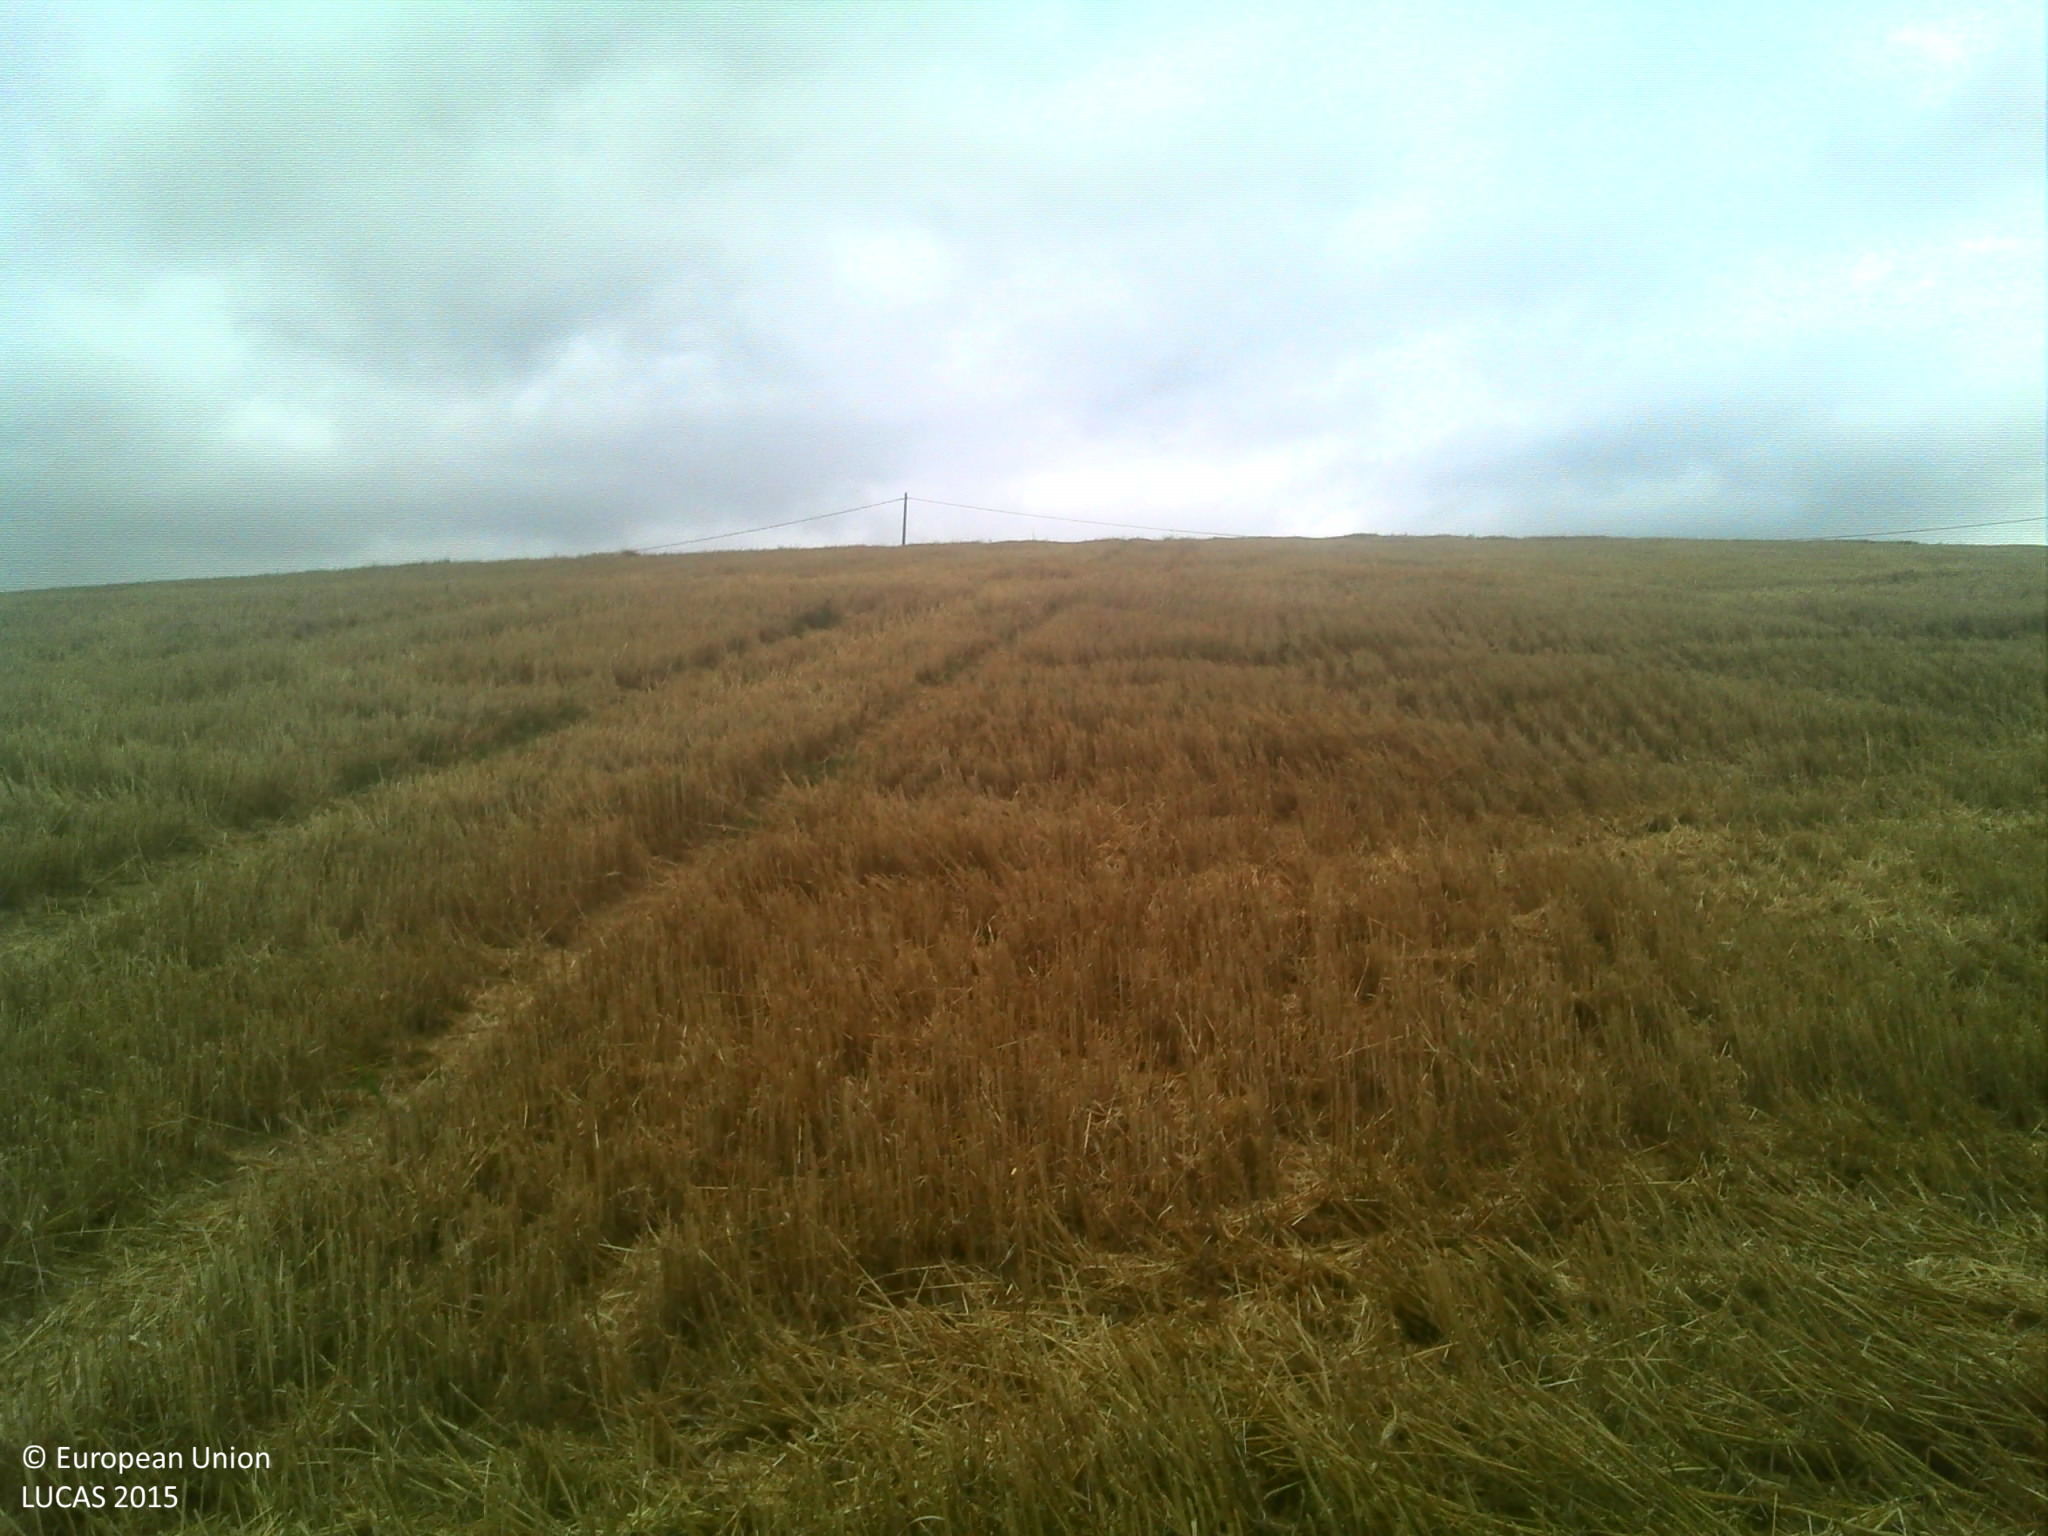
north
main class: Cropland
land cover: Common wheat
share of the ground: > 75 %
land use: Agriculture (excluding fallow land and kitchen gardens)
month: July
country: FR
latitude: 43.2849
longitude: 1.3898
